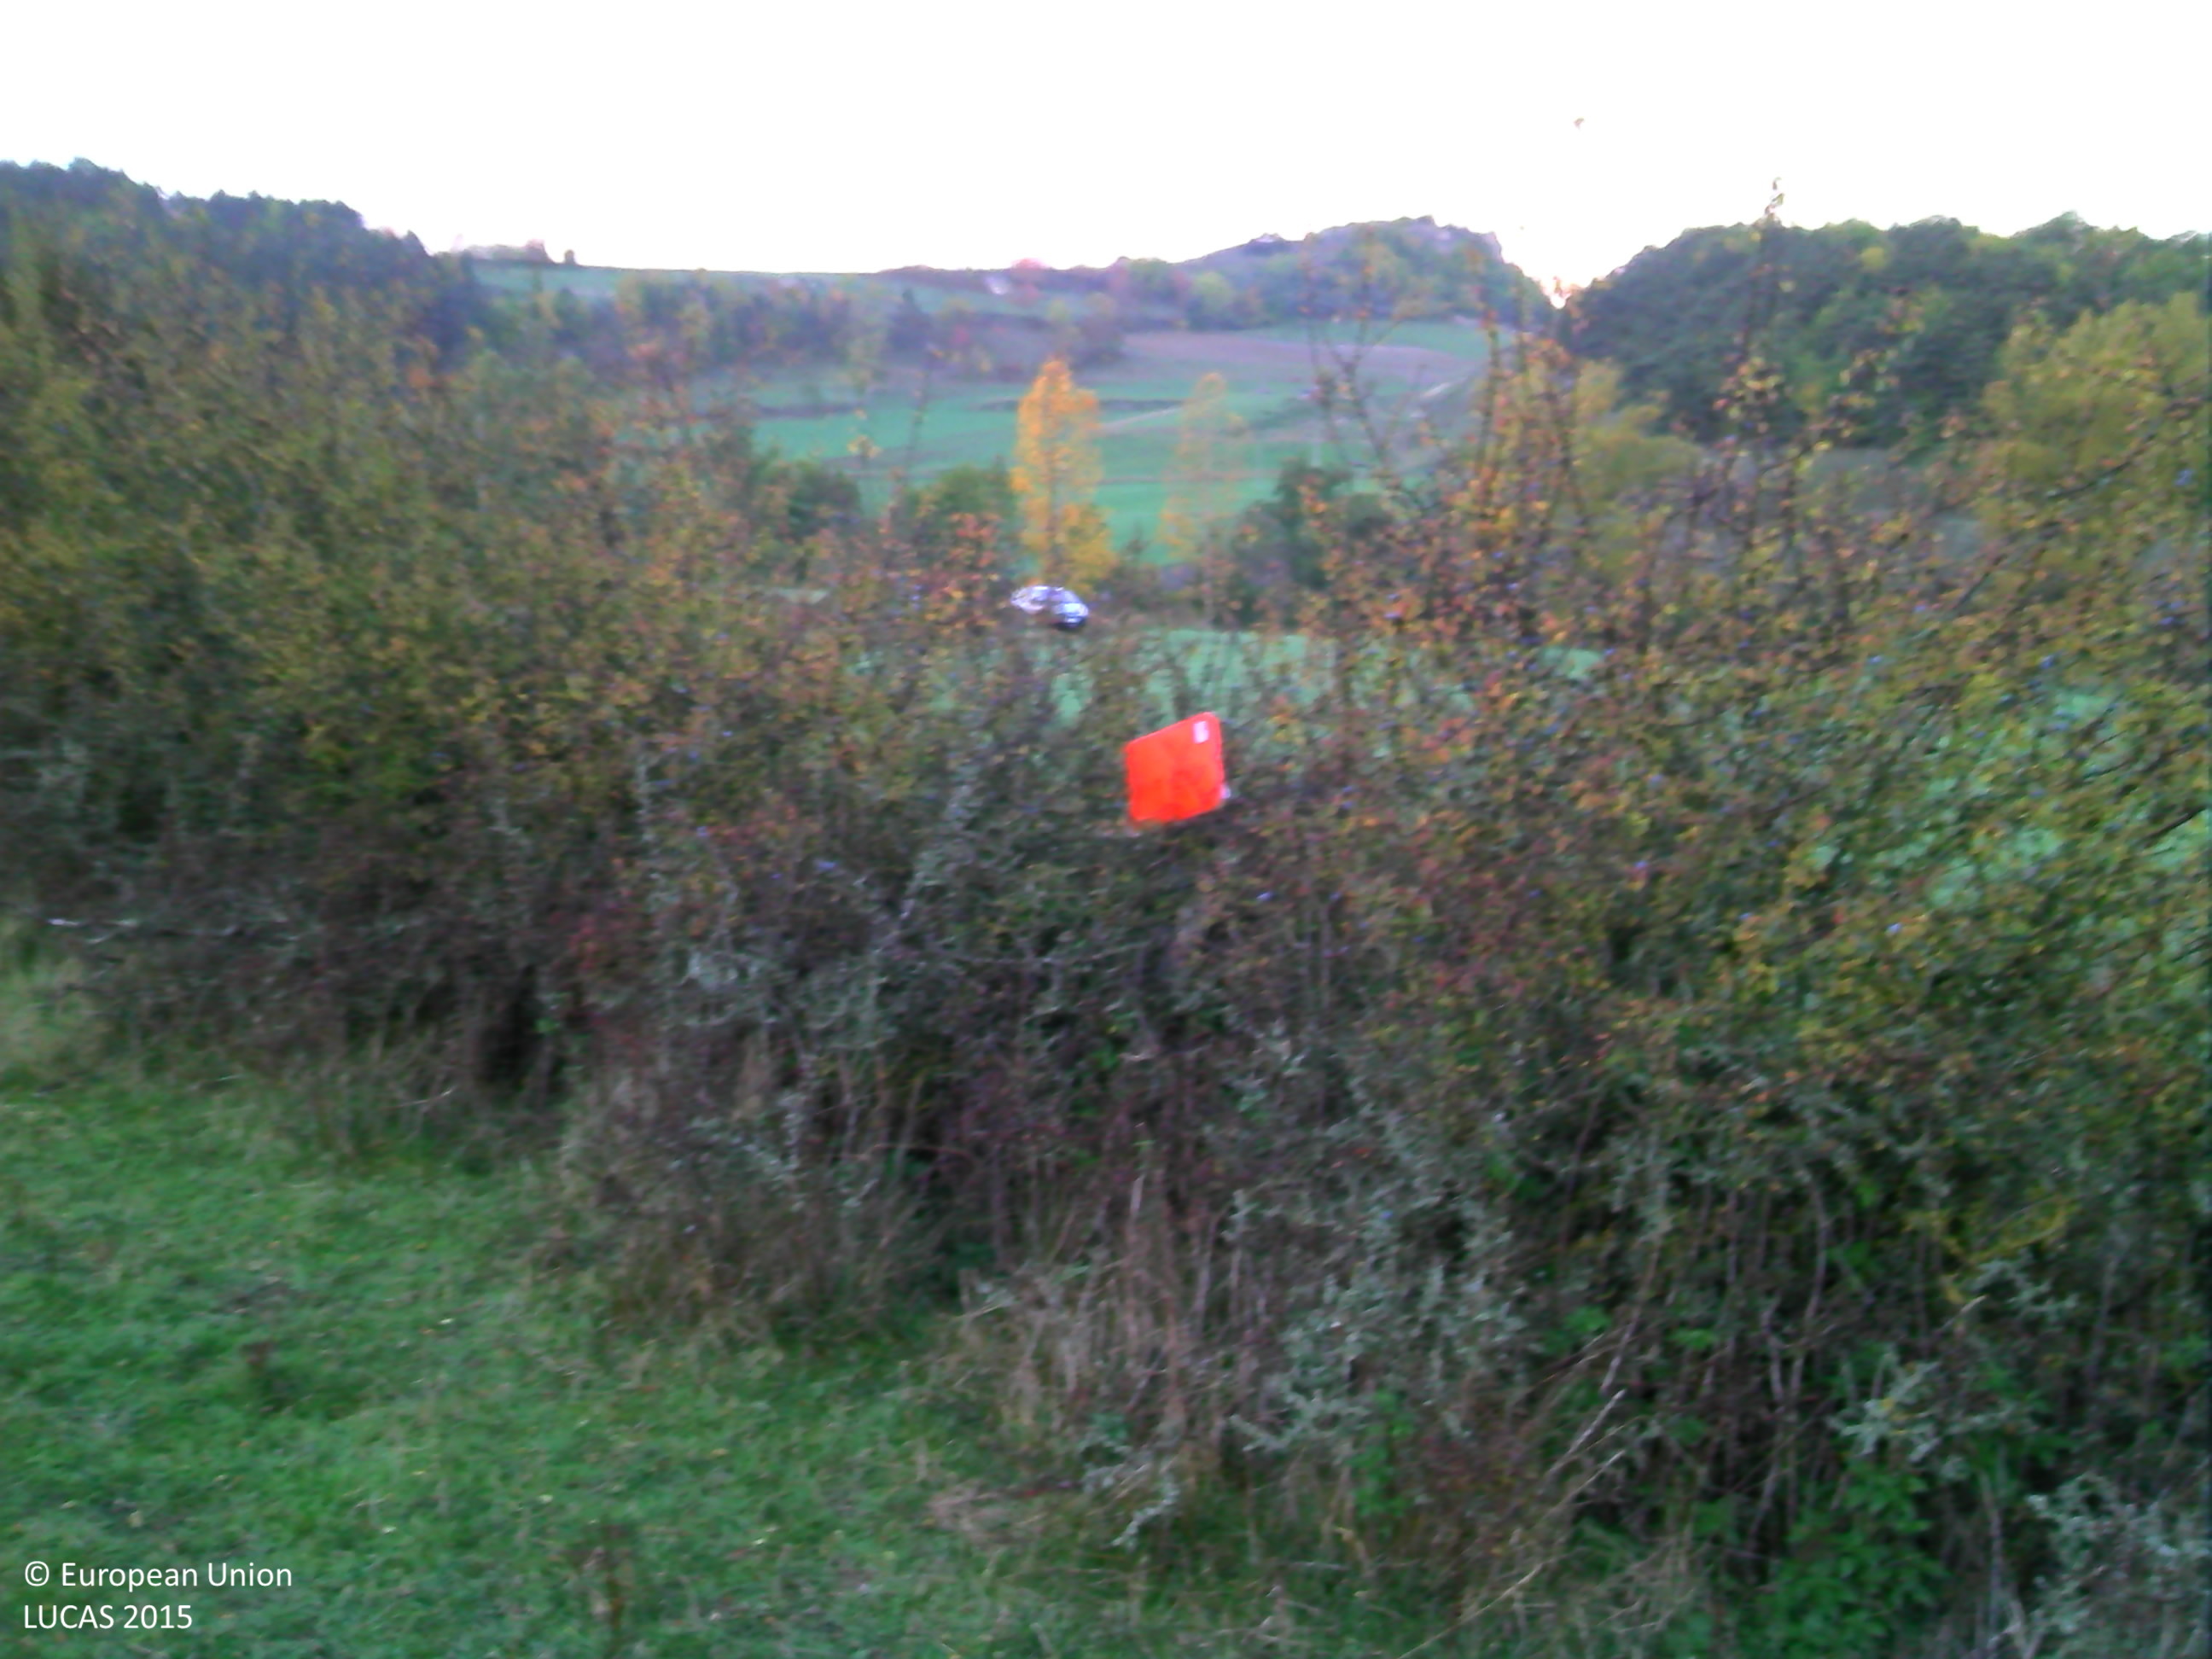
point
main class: Cropland
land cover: Common wheat
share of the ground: 25 - 50 %
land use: Agriculture (excluding fallow land and kitchen gardens)
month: October
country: FR
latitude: 45.0911
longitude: 3.8669
